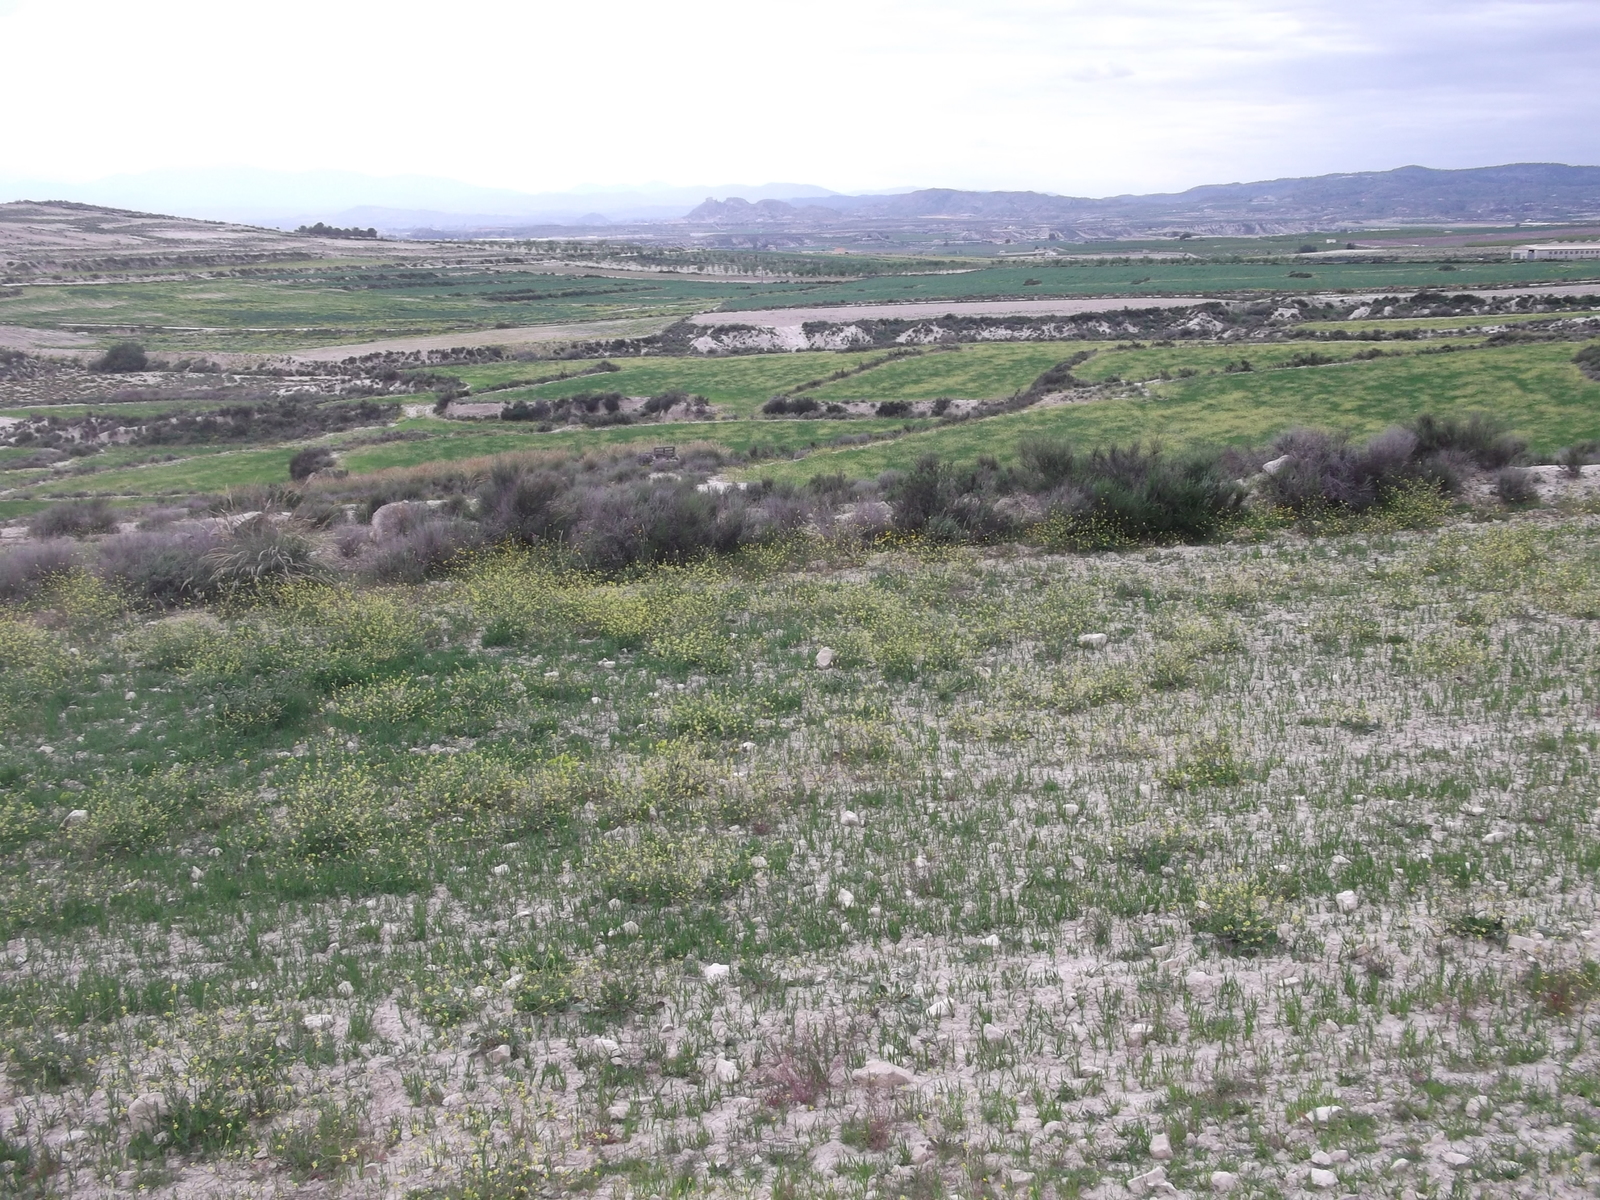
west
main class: Shrubland
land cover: Shrubland without tree cover
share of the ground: 10 - 25 %
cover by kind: consolidated bare surface 80 %, shrubs 20 %
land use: Semi-natural and natural areas not in use
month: April
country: ES
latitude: 38.0663
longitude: -1.3957
